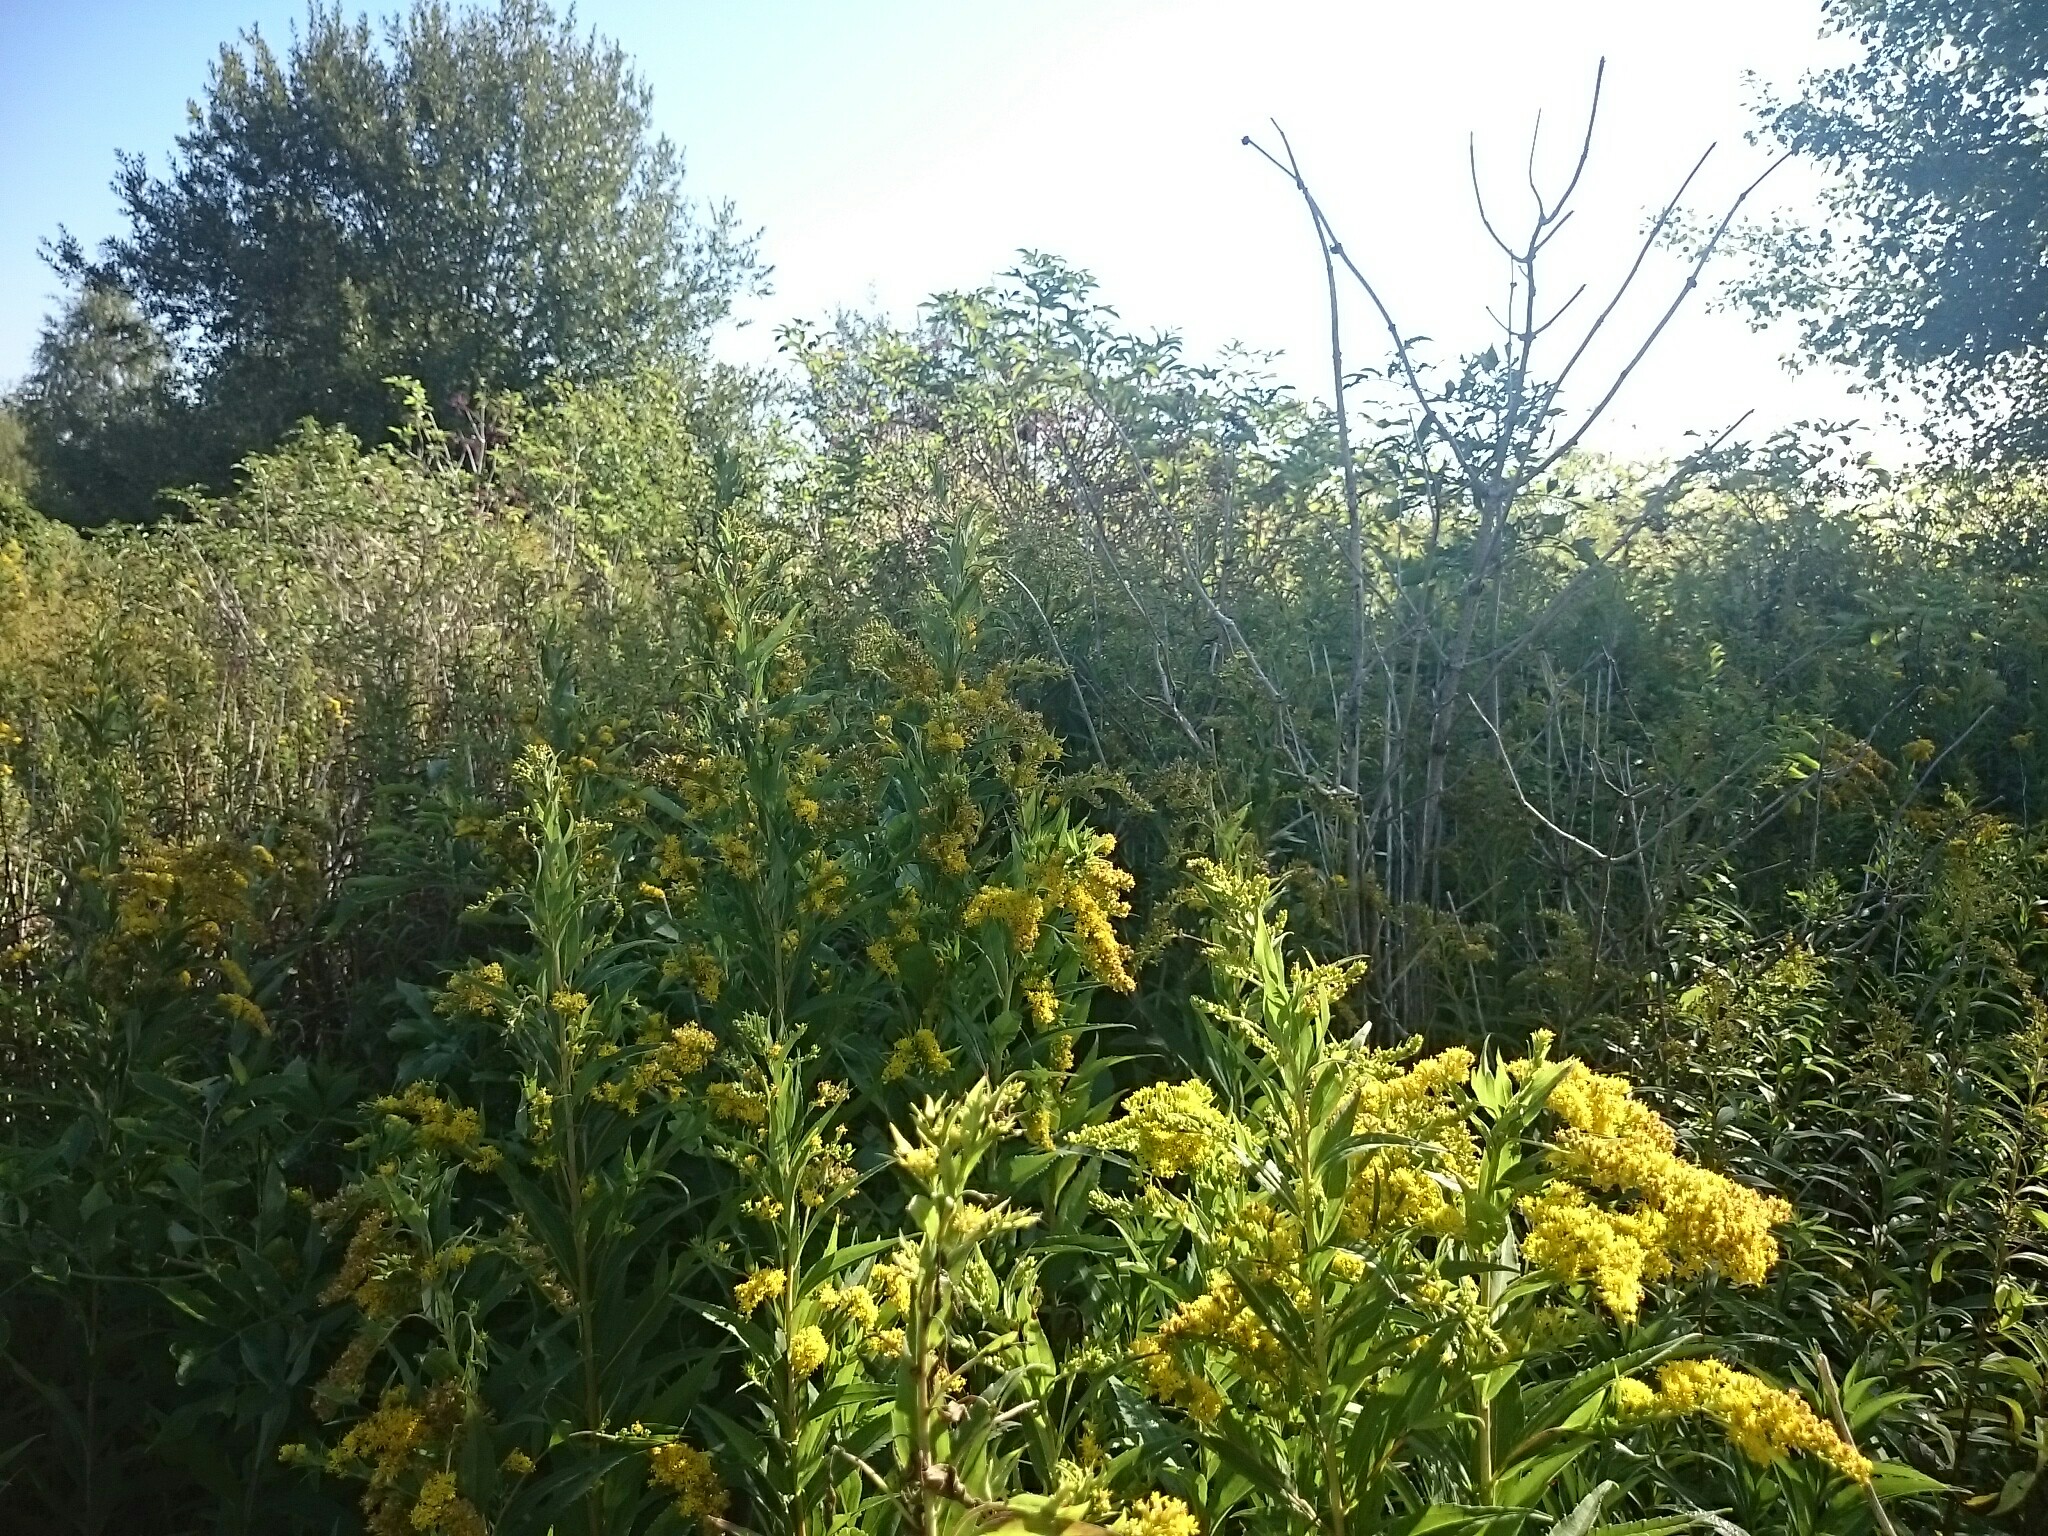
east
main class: Grassland
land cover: Grassland with sparse tree/shrub cover
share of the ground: > 75 %
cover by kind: herbaceous plants 90 %, broadleaved forest trees 5 %
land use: Semi-natural and natural areas not in use
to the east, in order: Grassland with sparse tree/shrub cover; Potatoes; Grass margins; Maize; Grassland without tree/shrub cover; Rye; Grass margins; Ditches and canals; Artificial constructions in urban areas
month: September
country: PL
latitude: 51.3034
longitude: 17.3127
